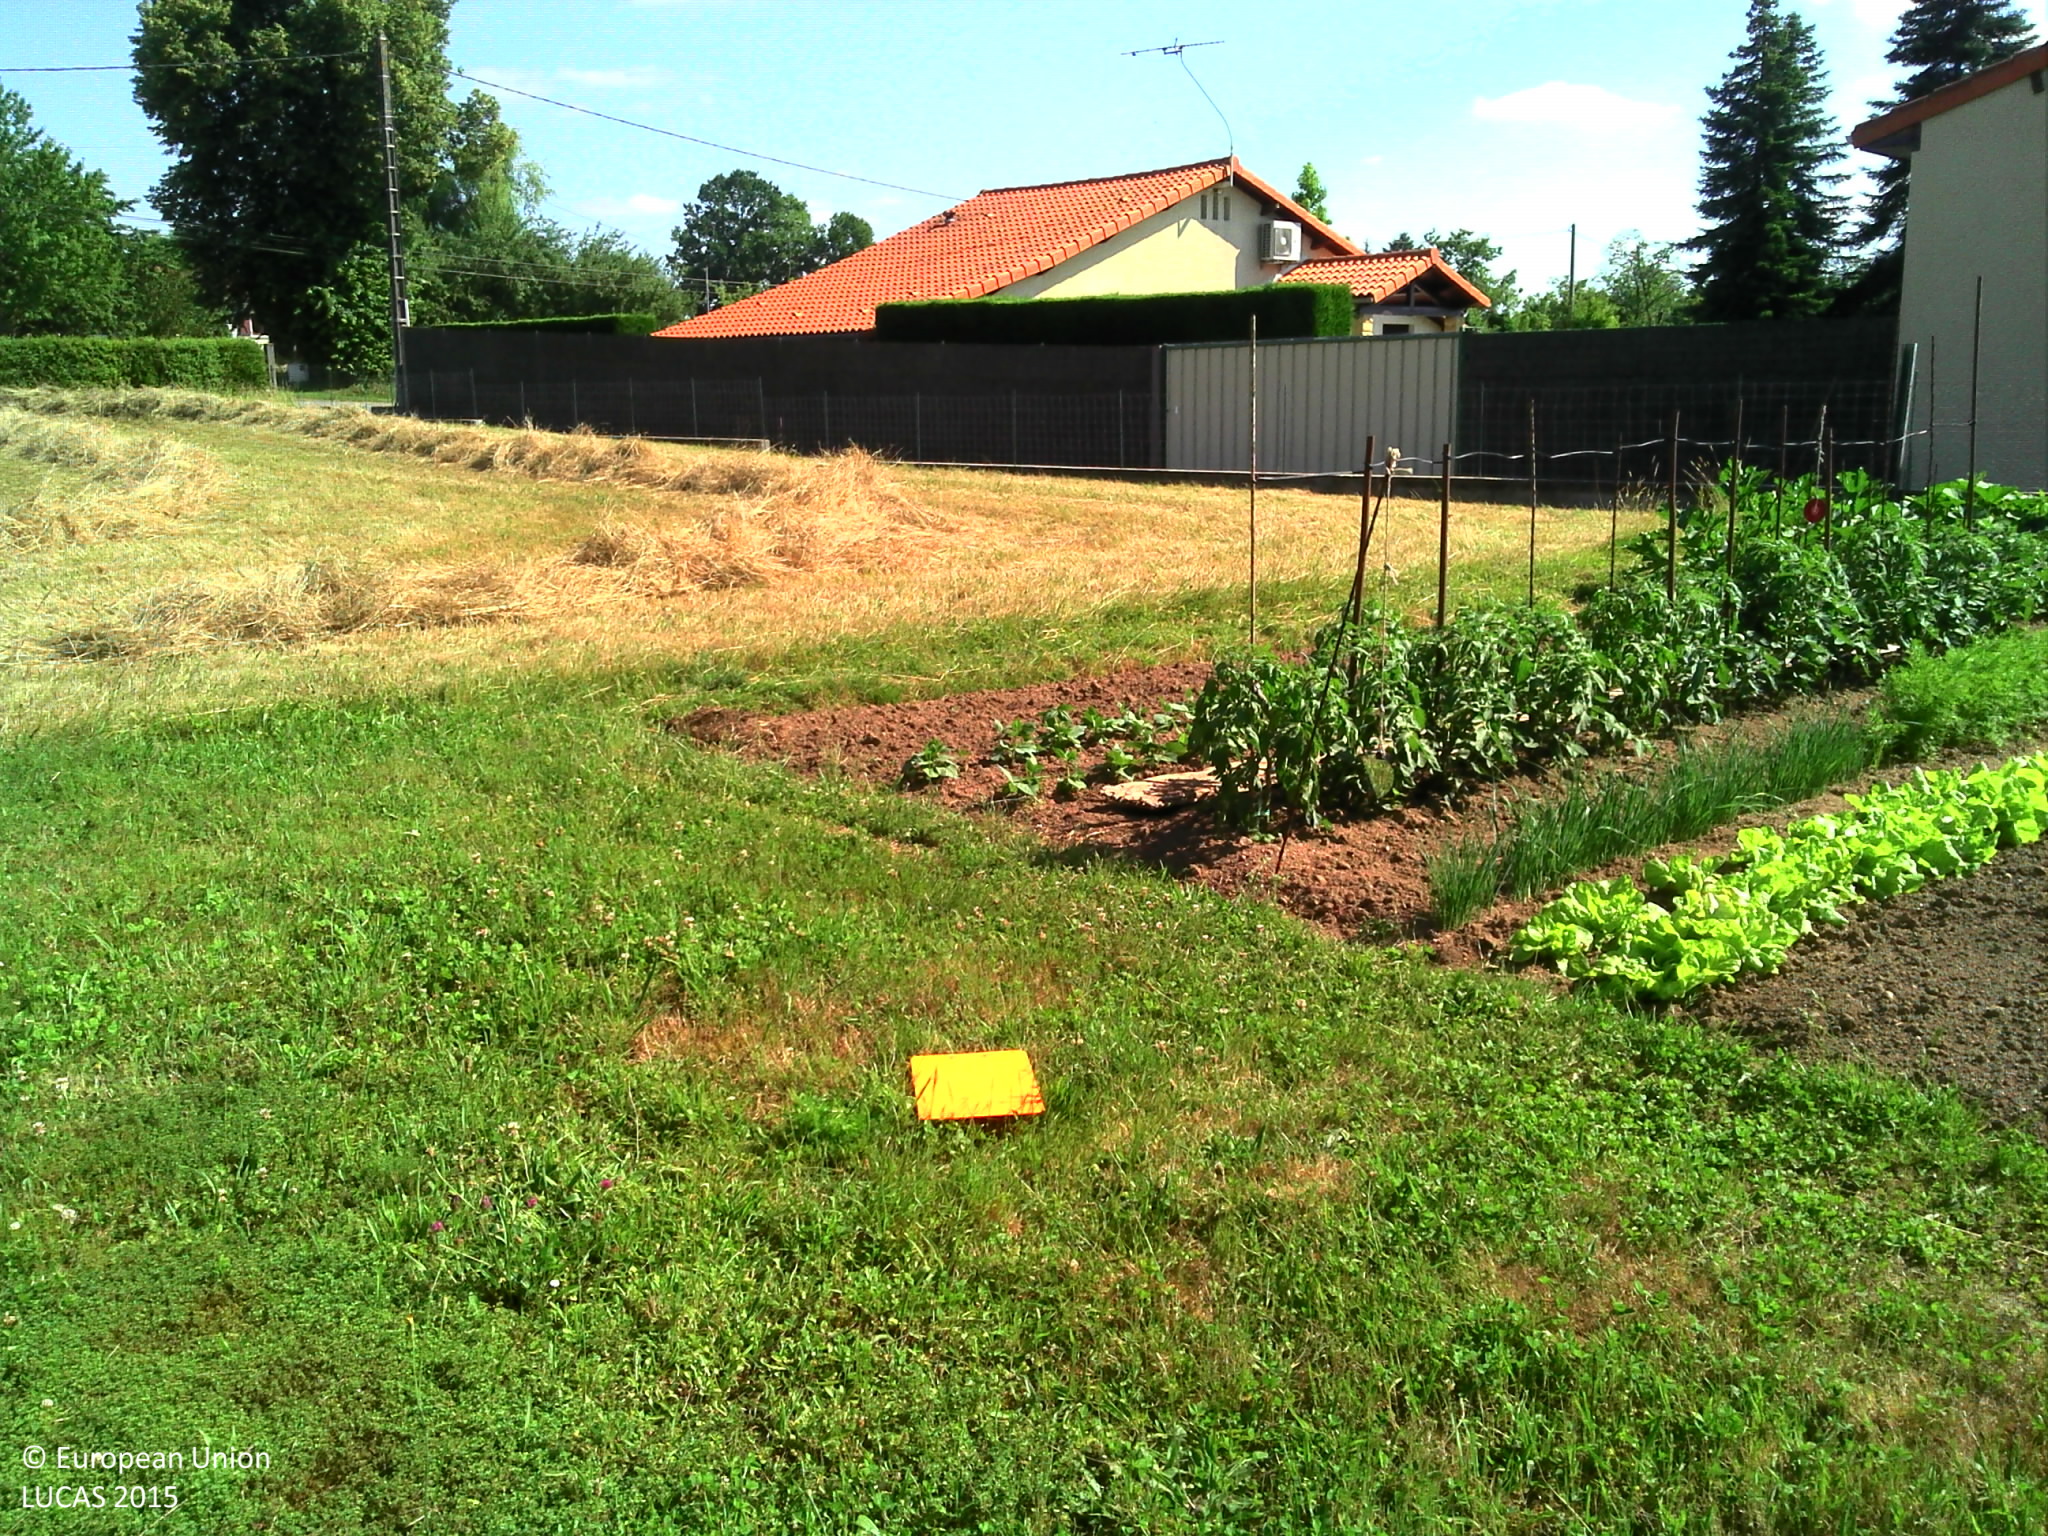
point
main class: Grassland
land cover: Grassland with sparse tree/shrub cover
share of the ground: > 75 %
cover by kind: herbaceous plants 95 %, broadleaved forest trees 5 %
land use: Agriculture (excluding fallow land and kitchen gardens)
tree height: > 5 m
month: June
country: FR
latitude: 45.8860
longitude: 0.6440
